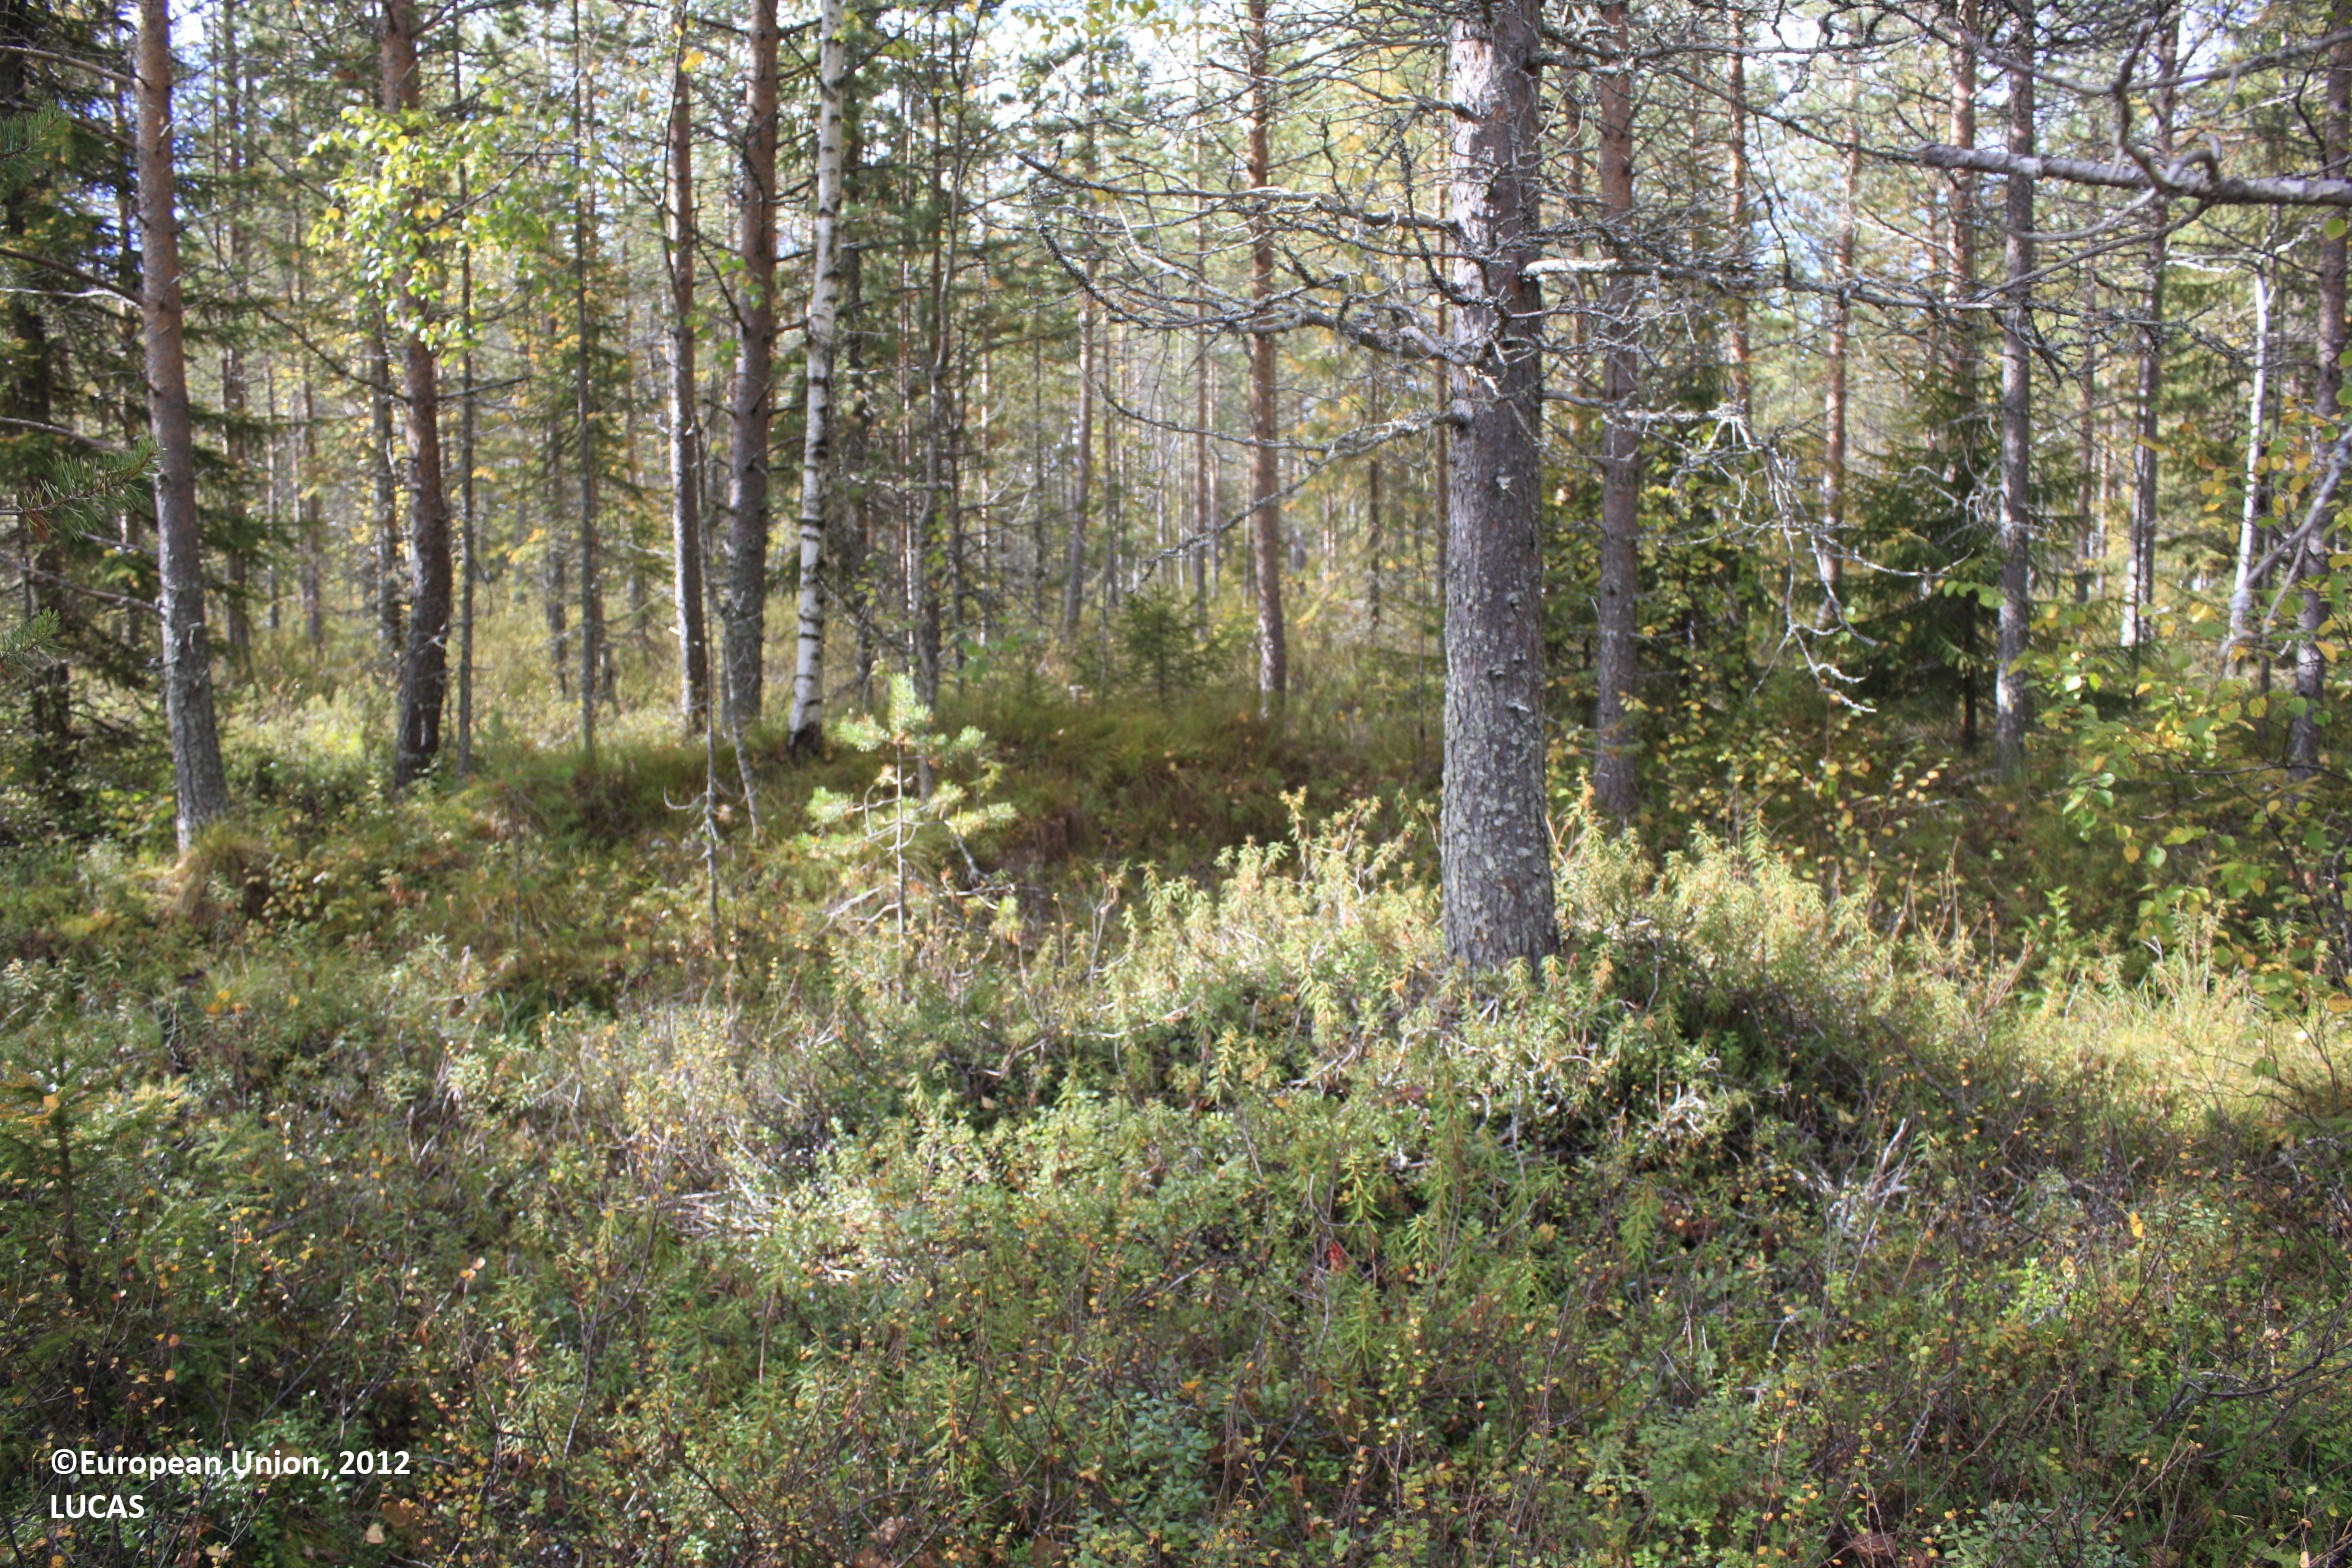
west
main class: Woodland
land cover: Pine dominated mixed woodland
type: mire and swamp forests
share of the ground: 25 - 50 %
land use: Forestry
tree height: > 5 m
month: September
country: FI
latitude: 65.6713
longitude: 26.5684
